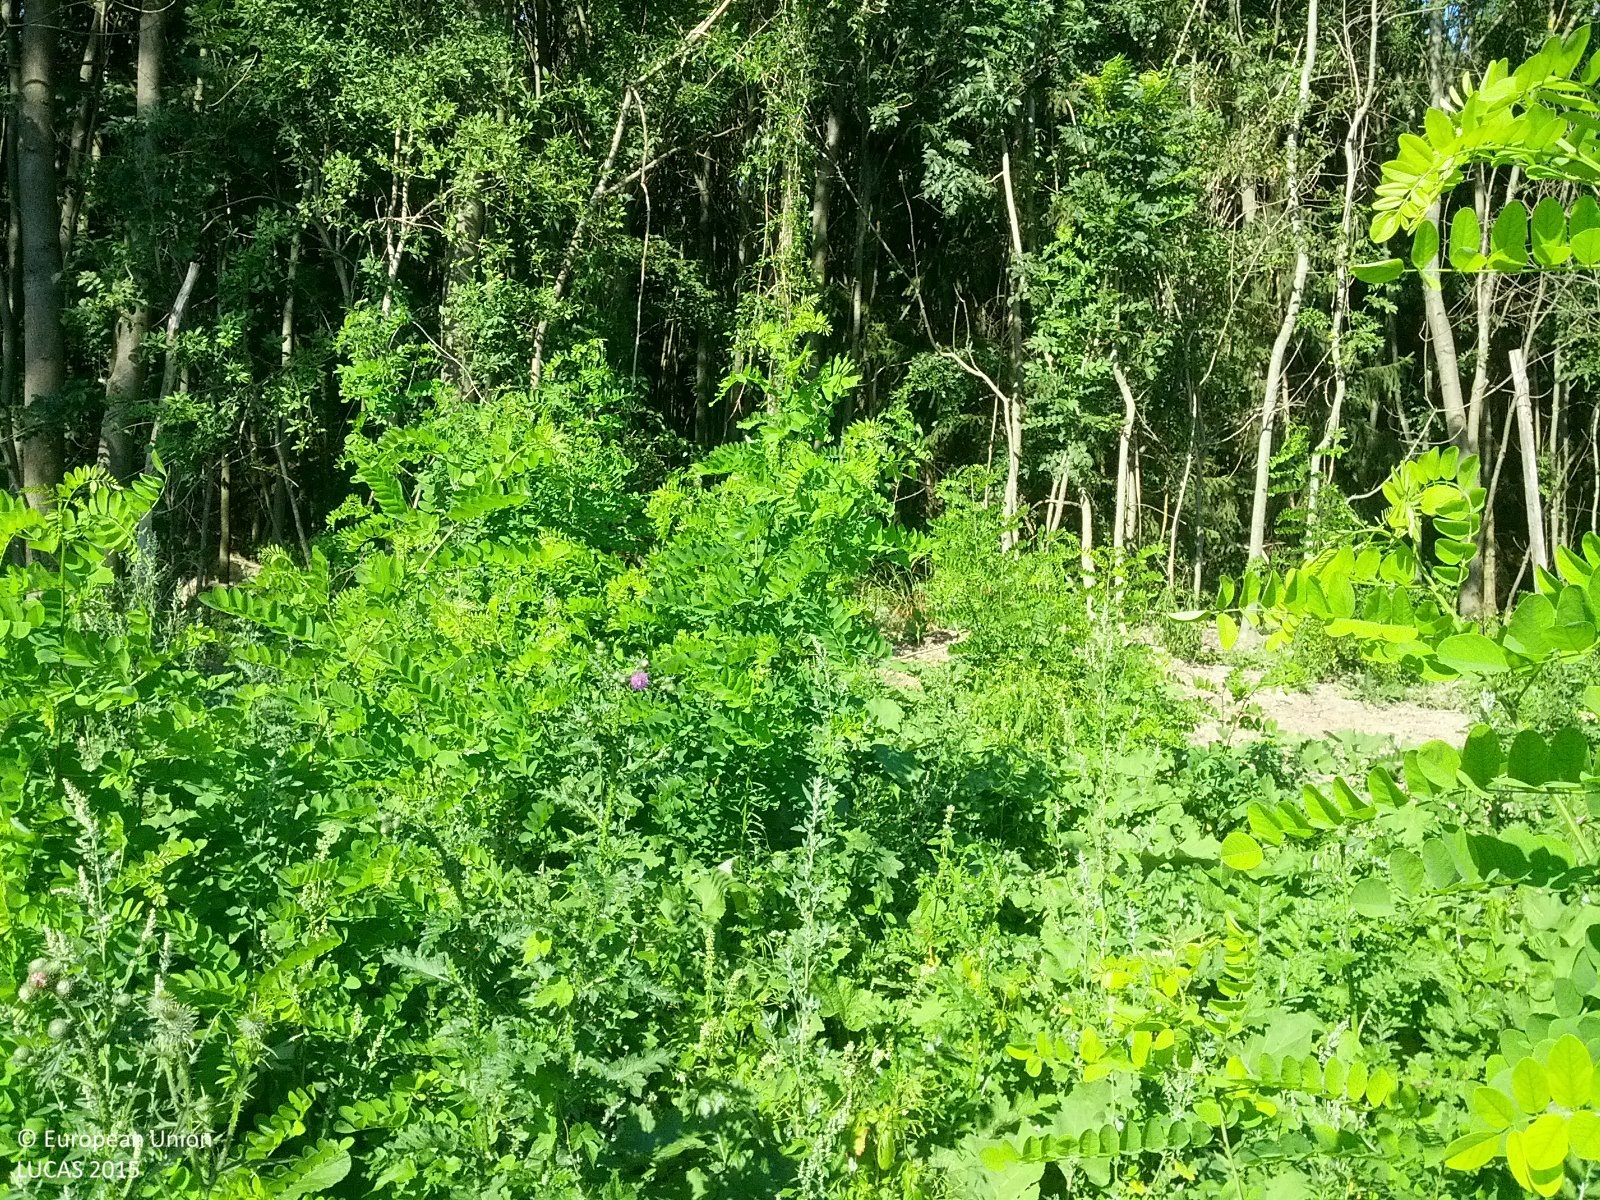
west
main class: Shrubland
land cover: Shrubland with sparse tree cover
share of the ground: > 75 %
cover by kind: shrubs 70 %, herbaceous plants 25 %, broadleaved forest trees 5 %
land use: Forestry
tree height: > 5 m
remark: Clear cut
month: July
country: AT
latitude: 48.4709
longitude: 16.0776
